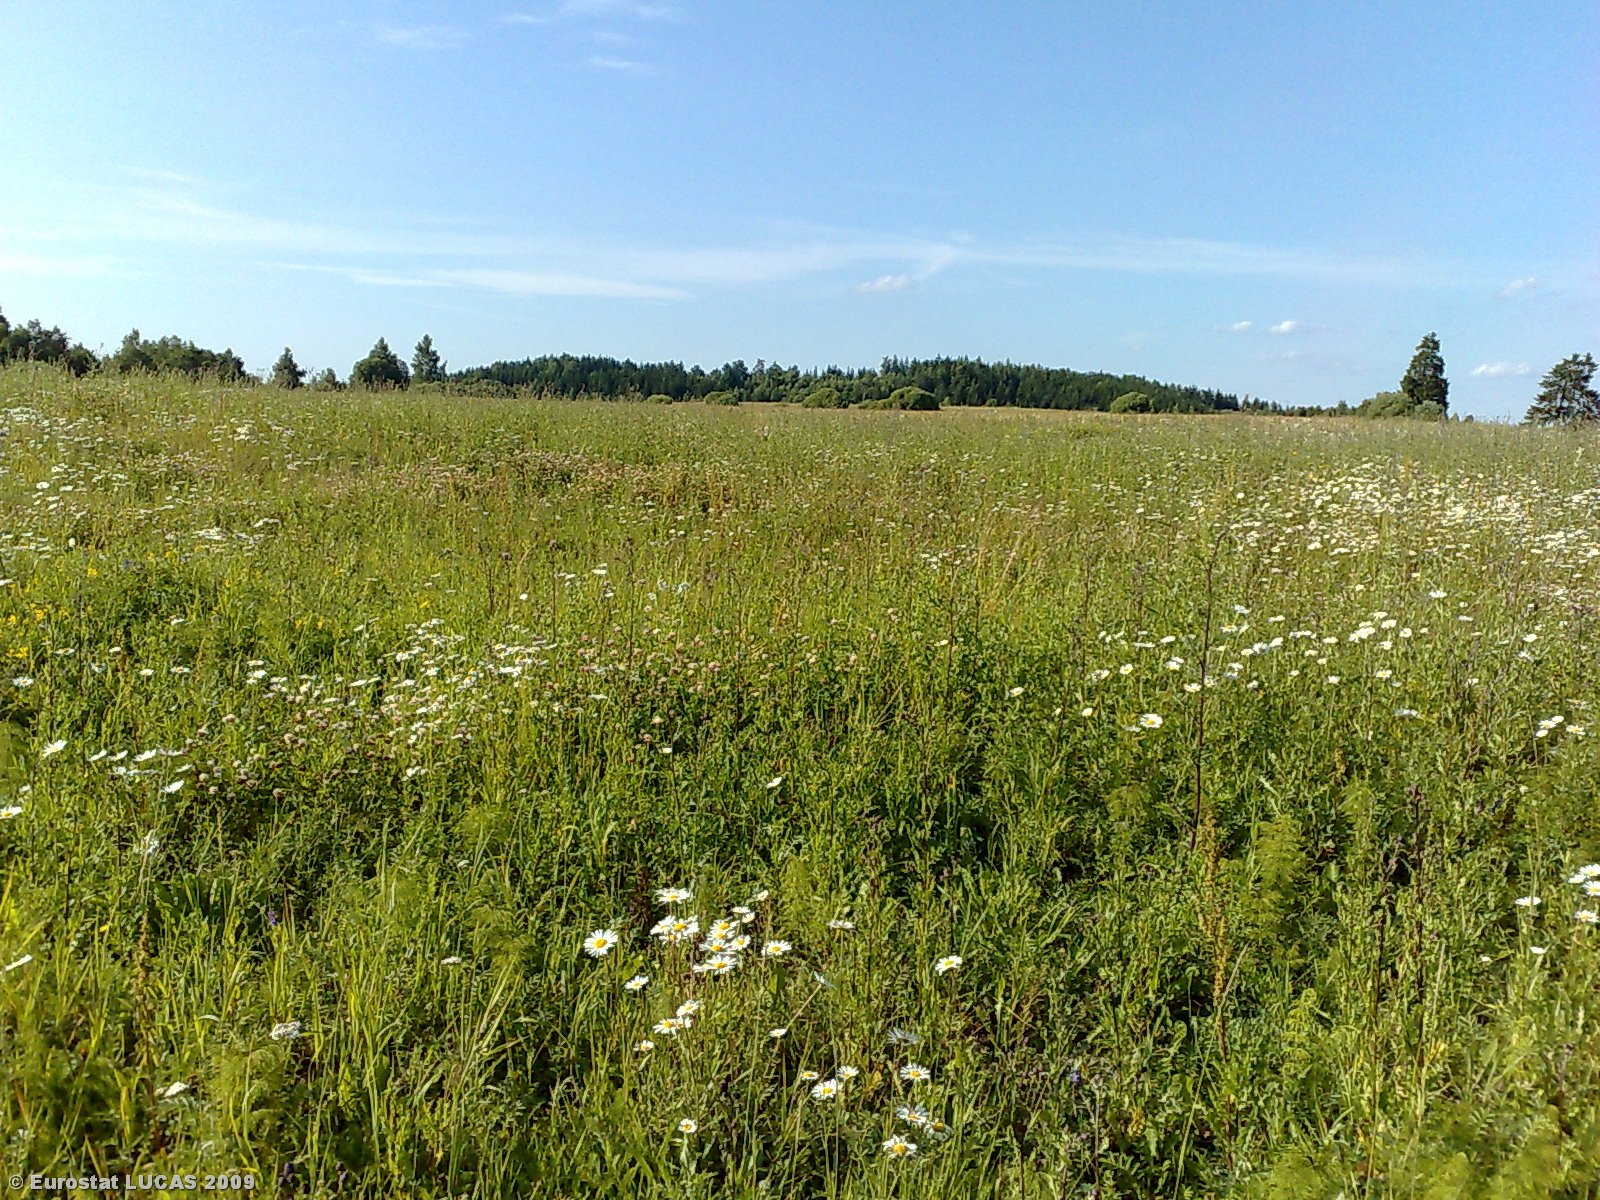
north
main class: Grassland
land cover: Grassland without tree/shrub cover
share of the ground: > 75 %
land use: Agriculture (excluding fallow land and kitchen gardens)
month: July
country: LT
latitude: 55.5328
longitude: 22.7239
